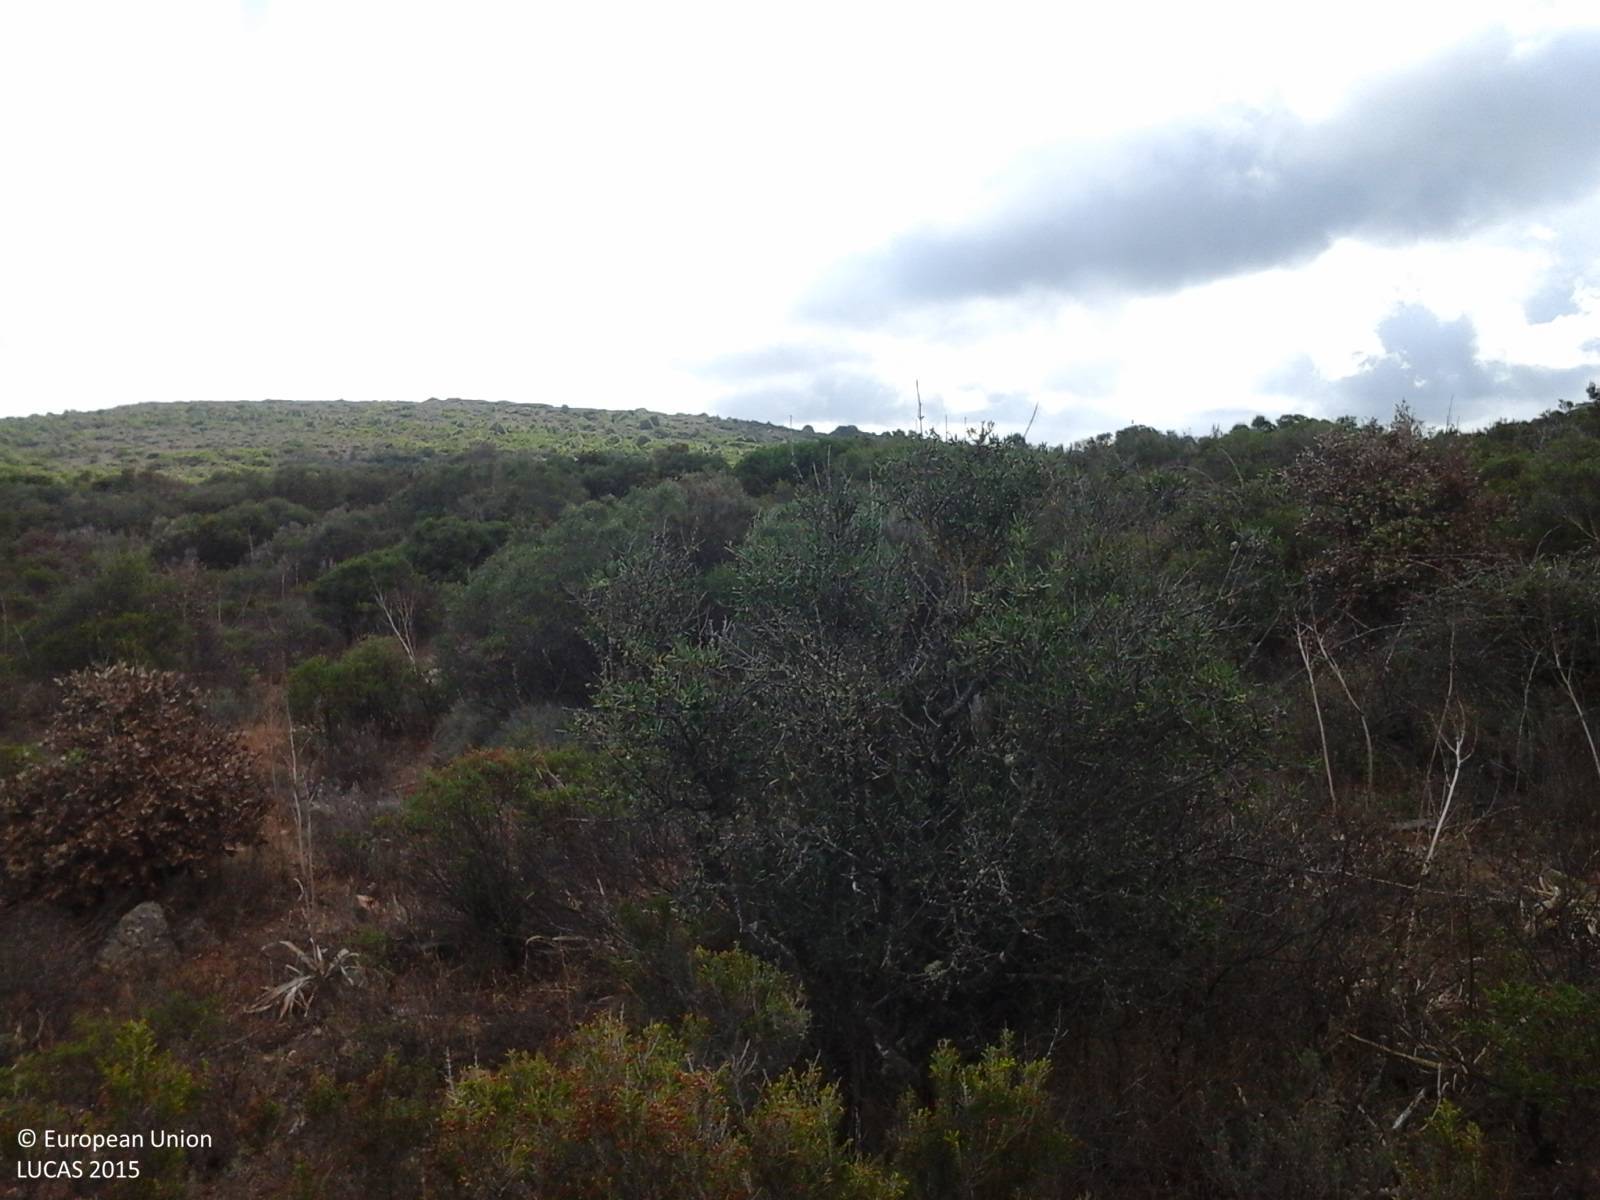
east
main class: Shrubland
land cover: Shrubland without tree cover
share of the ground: > 75 %
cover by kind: shrubs 70 %, herbaceous plants 30 %
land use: Semi-natural and natural areas not in use
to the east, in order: Shrubland without tree cover; Paved roads, cycling and walking lanes; Fences; Shrubland without tree cover
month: August
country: IT
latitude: 40.6620
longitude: 9.1643
